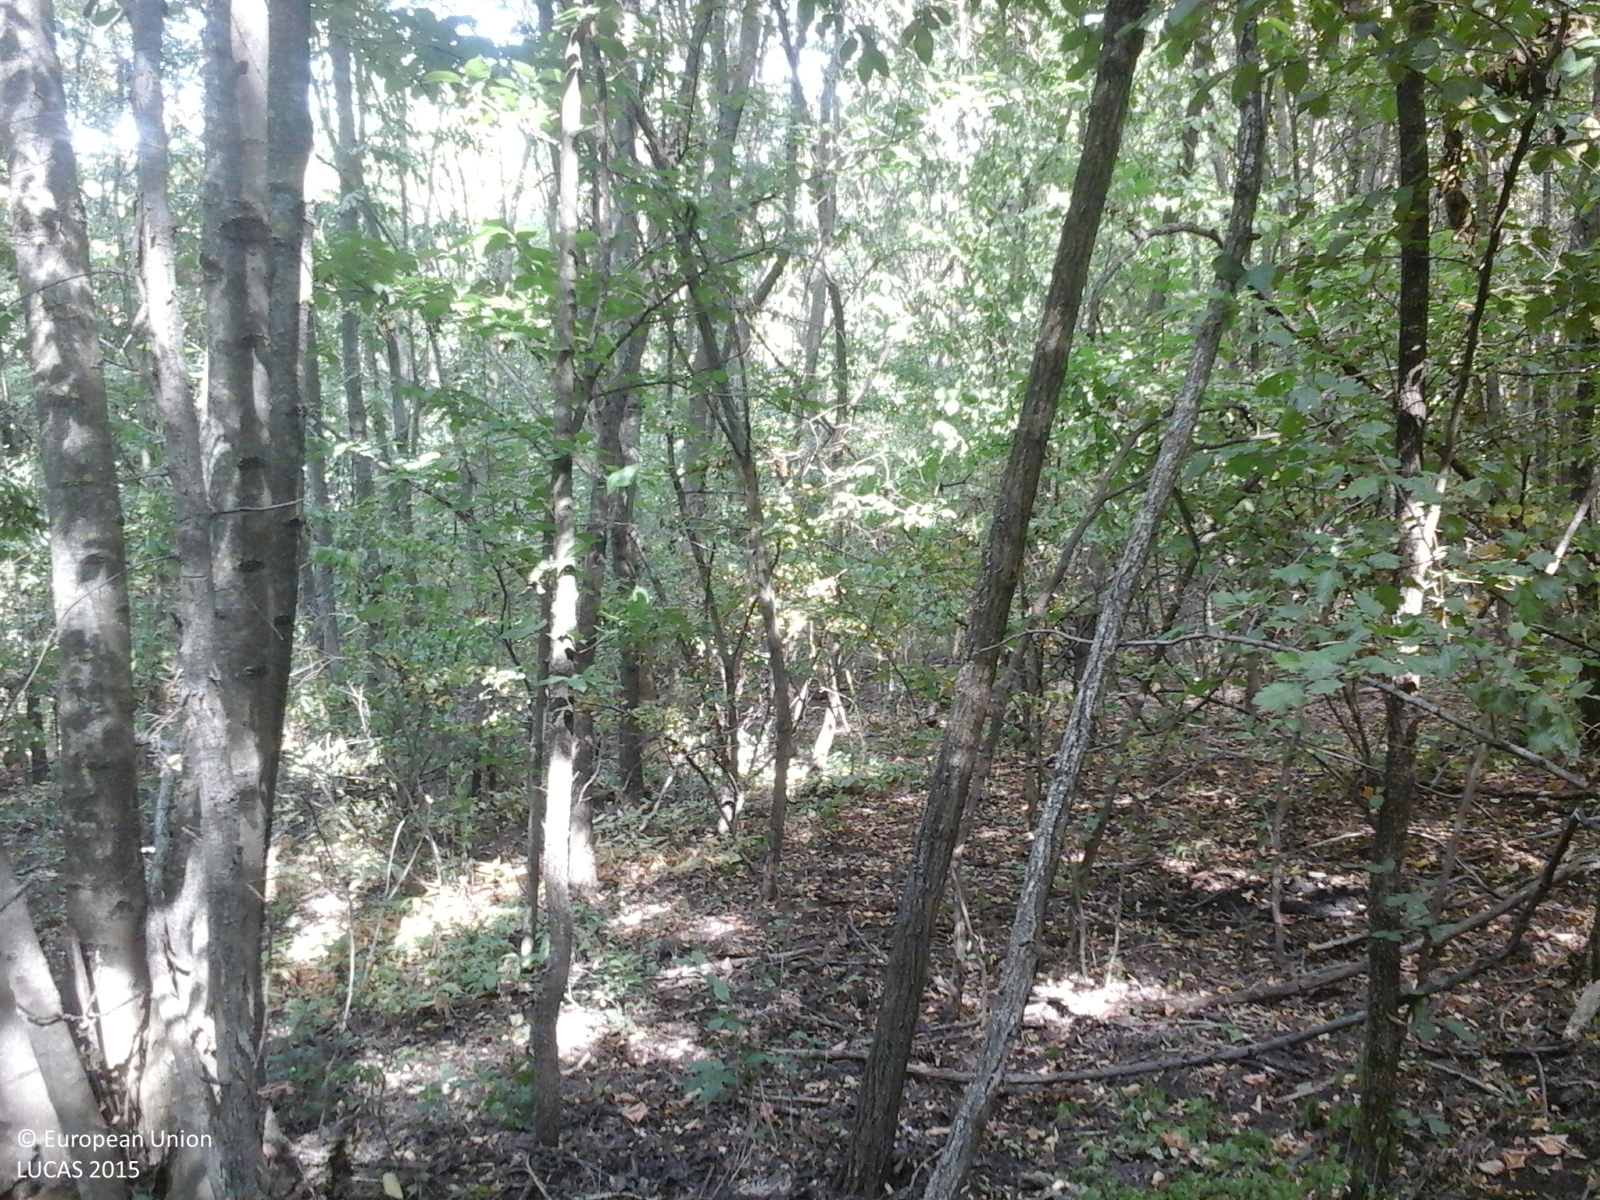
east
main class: Woodland
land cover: Broadleaved woodland
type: acidophilous oak and oak-birch forest
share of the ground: > 75 %
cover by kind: broadleaved forest trees 100 %
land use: Forestry
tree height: > 5 m
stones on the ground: < 10 %
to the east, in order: Broadleaved woodland
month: July
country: RO
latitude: 46.2484
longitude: 27.8771
